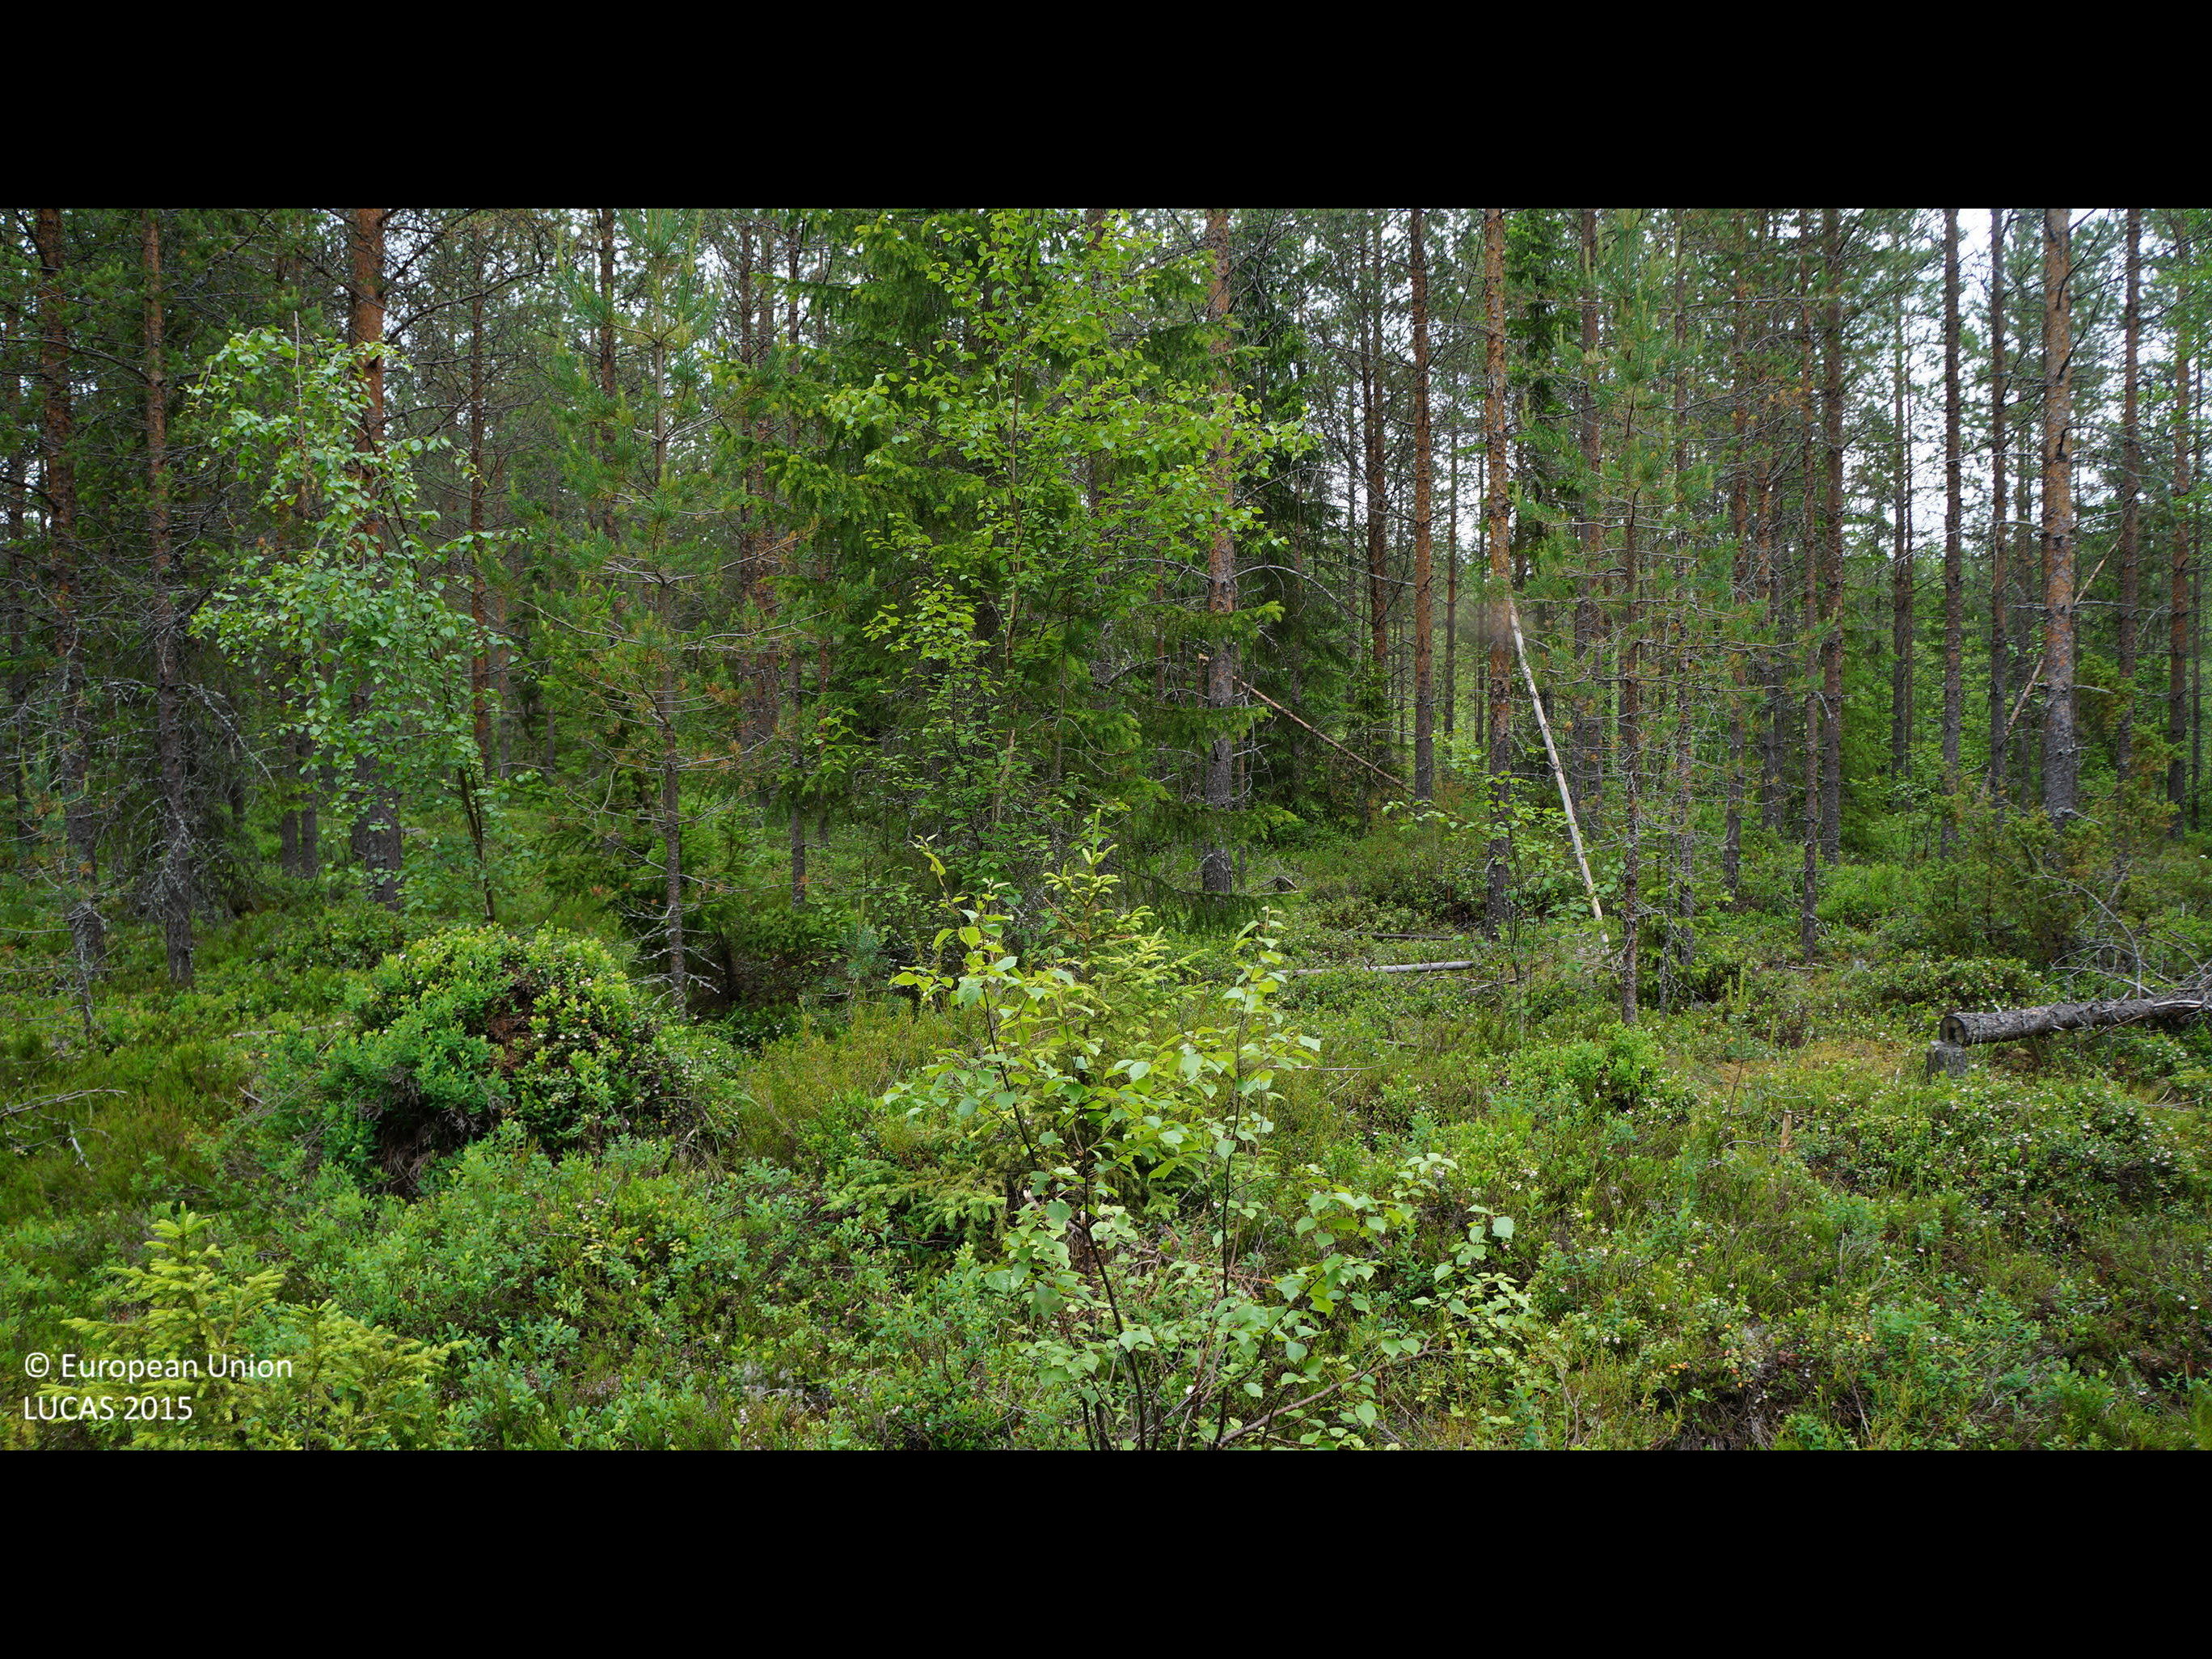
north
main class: Shrubland
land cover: Shrubland with sparse tree cover
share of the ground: > 75 %
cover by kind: shrubs 90 %, broadleaved forest trees 5 %, lichens and mosses 5 %
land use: Electricity, gas and thermal power distribution
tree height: < 5 m
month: July
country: FI
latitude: 64.2907
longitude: 24.3872
